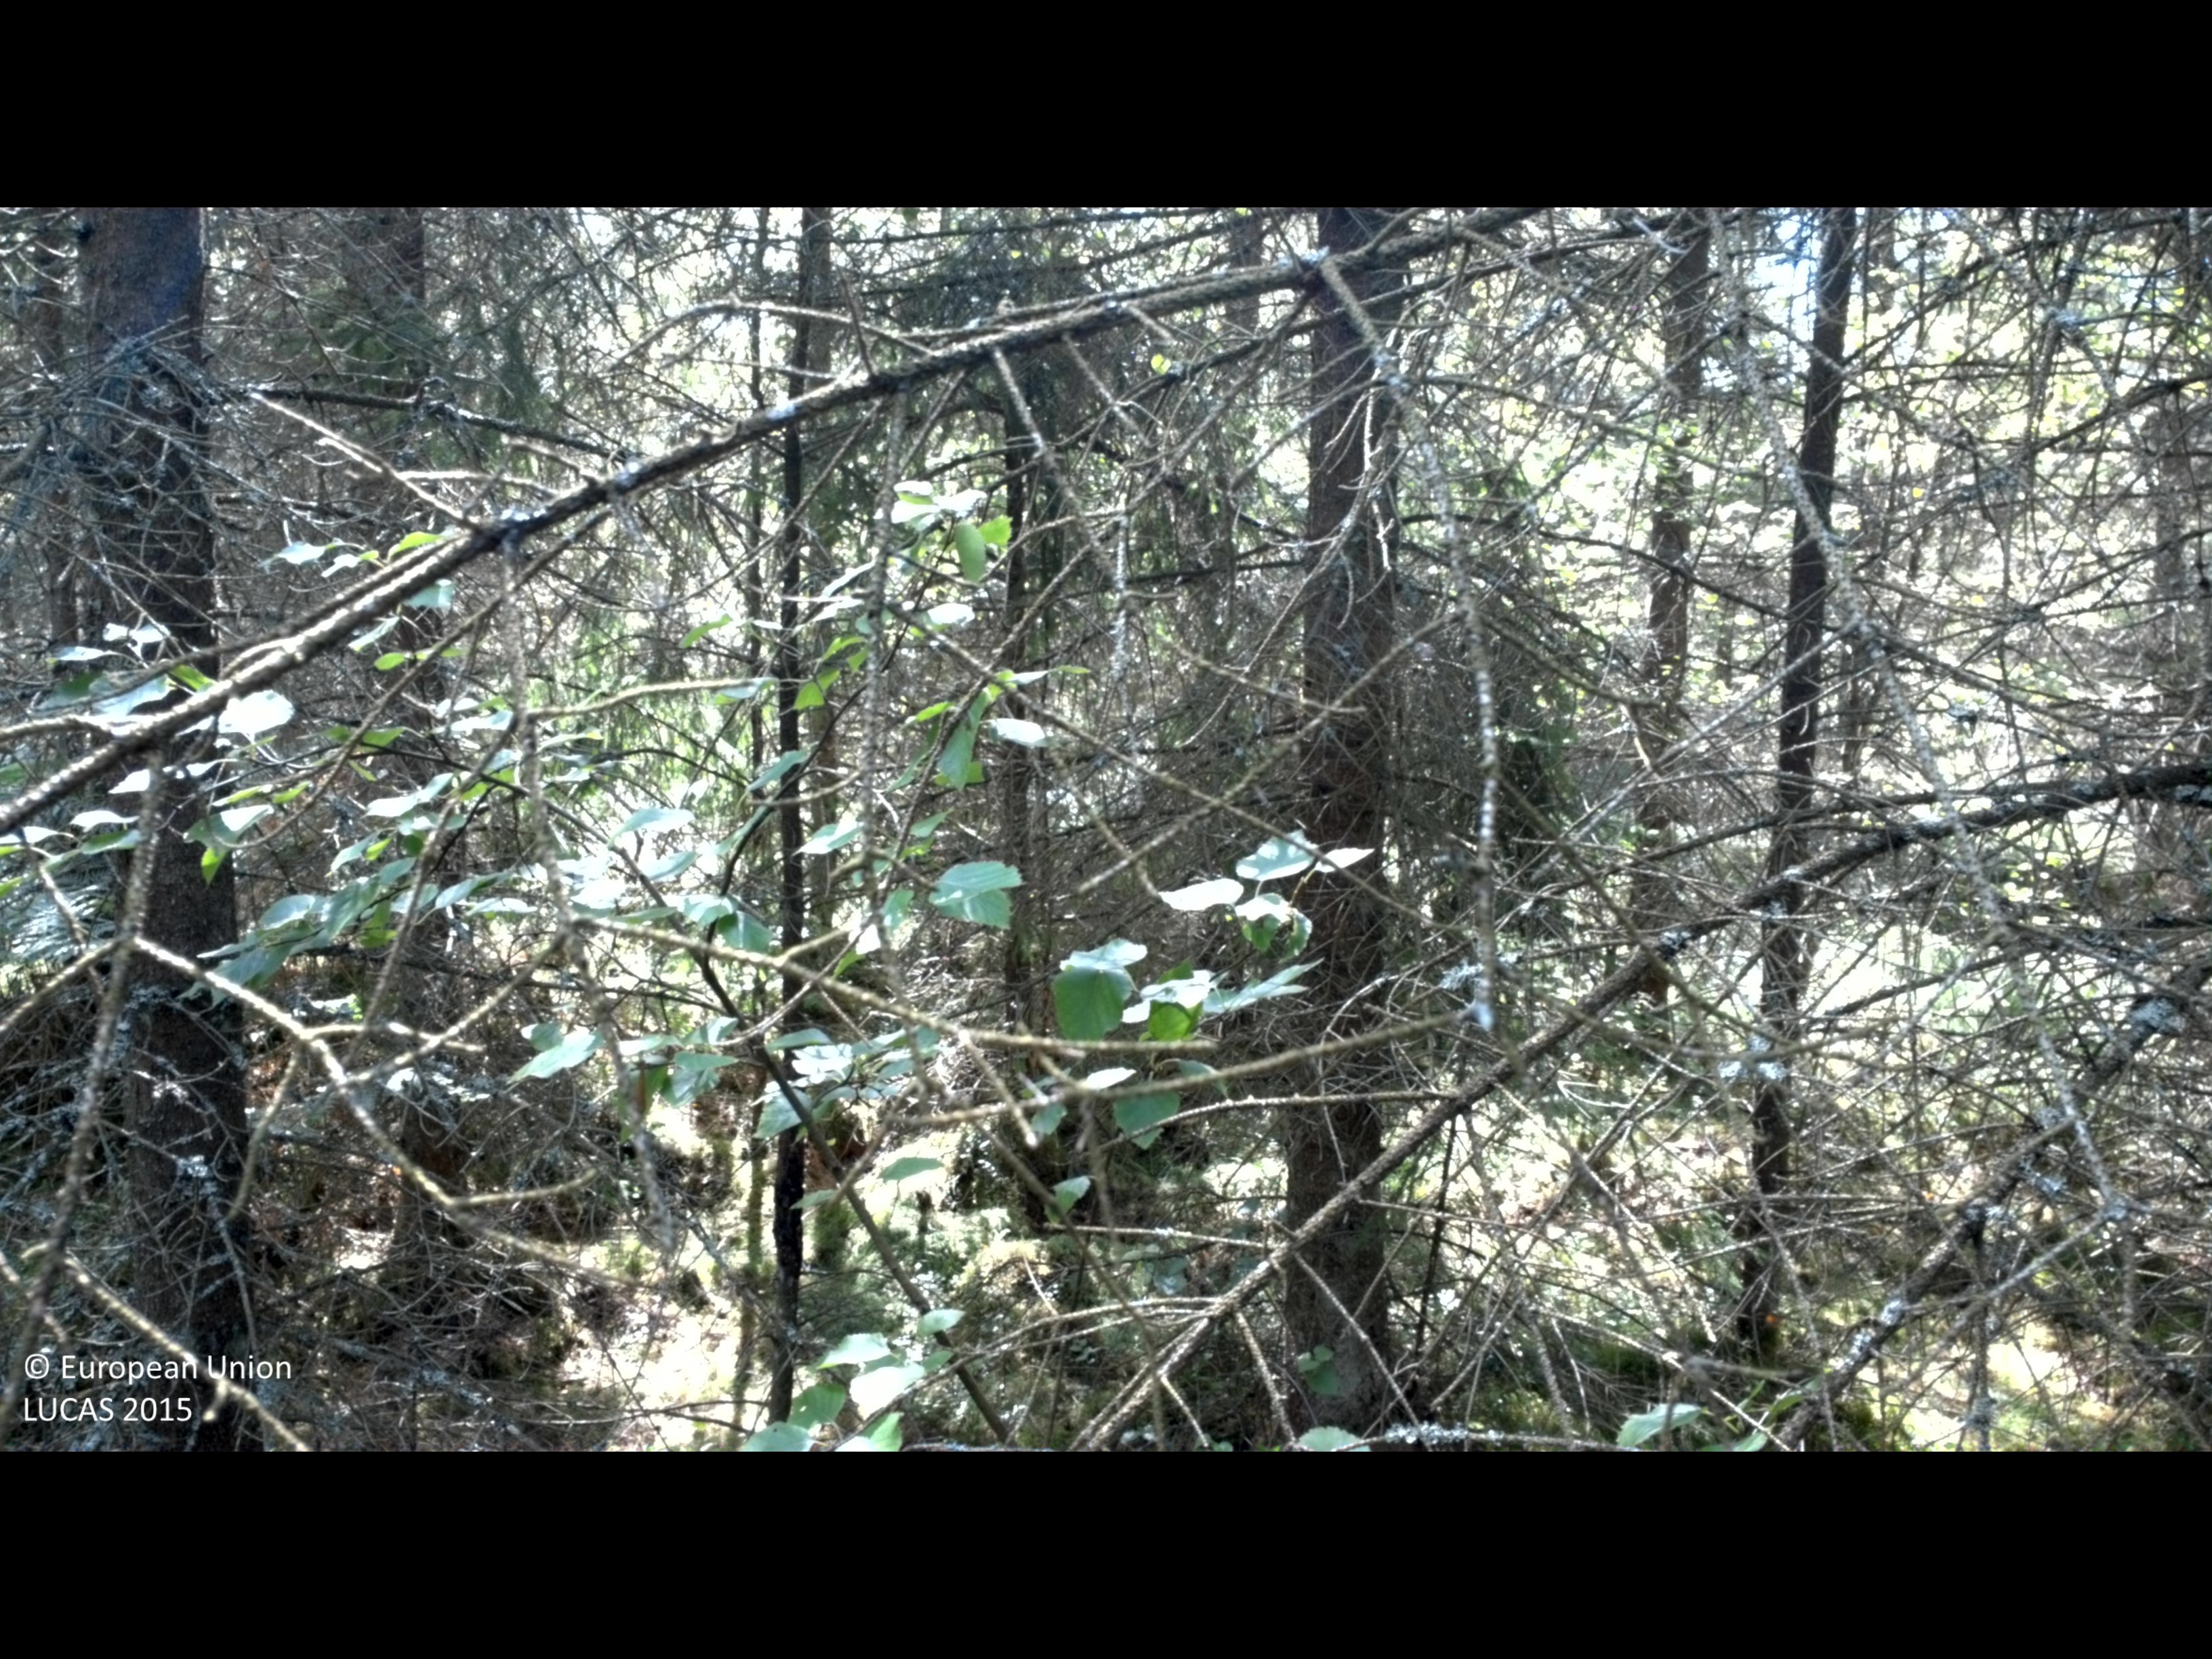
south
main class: Woodland
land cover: Spruce dominated coniferous woodland
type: boreal forest
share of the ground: > 75 %
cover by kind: coniferous forest trees 60 %, broadleaved forest trees 15 %, shrubs 15 %, herbaceous plants 5 %, lichens and mosses 5 %
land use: Forestry
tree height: > 5 m
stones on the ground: 10 - 25 %
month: August
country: SE
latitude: 56.9757
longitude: 13.8626
